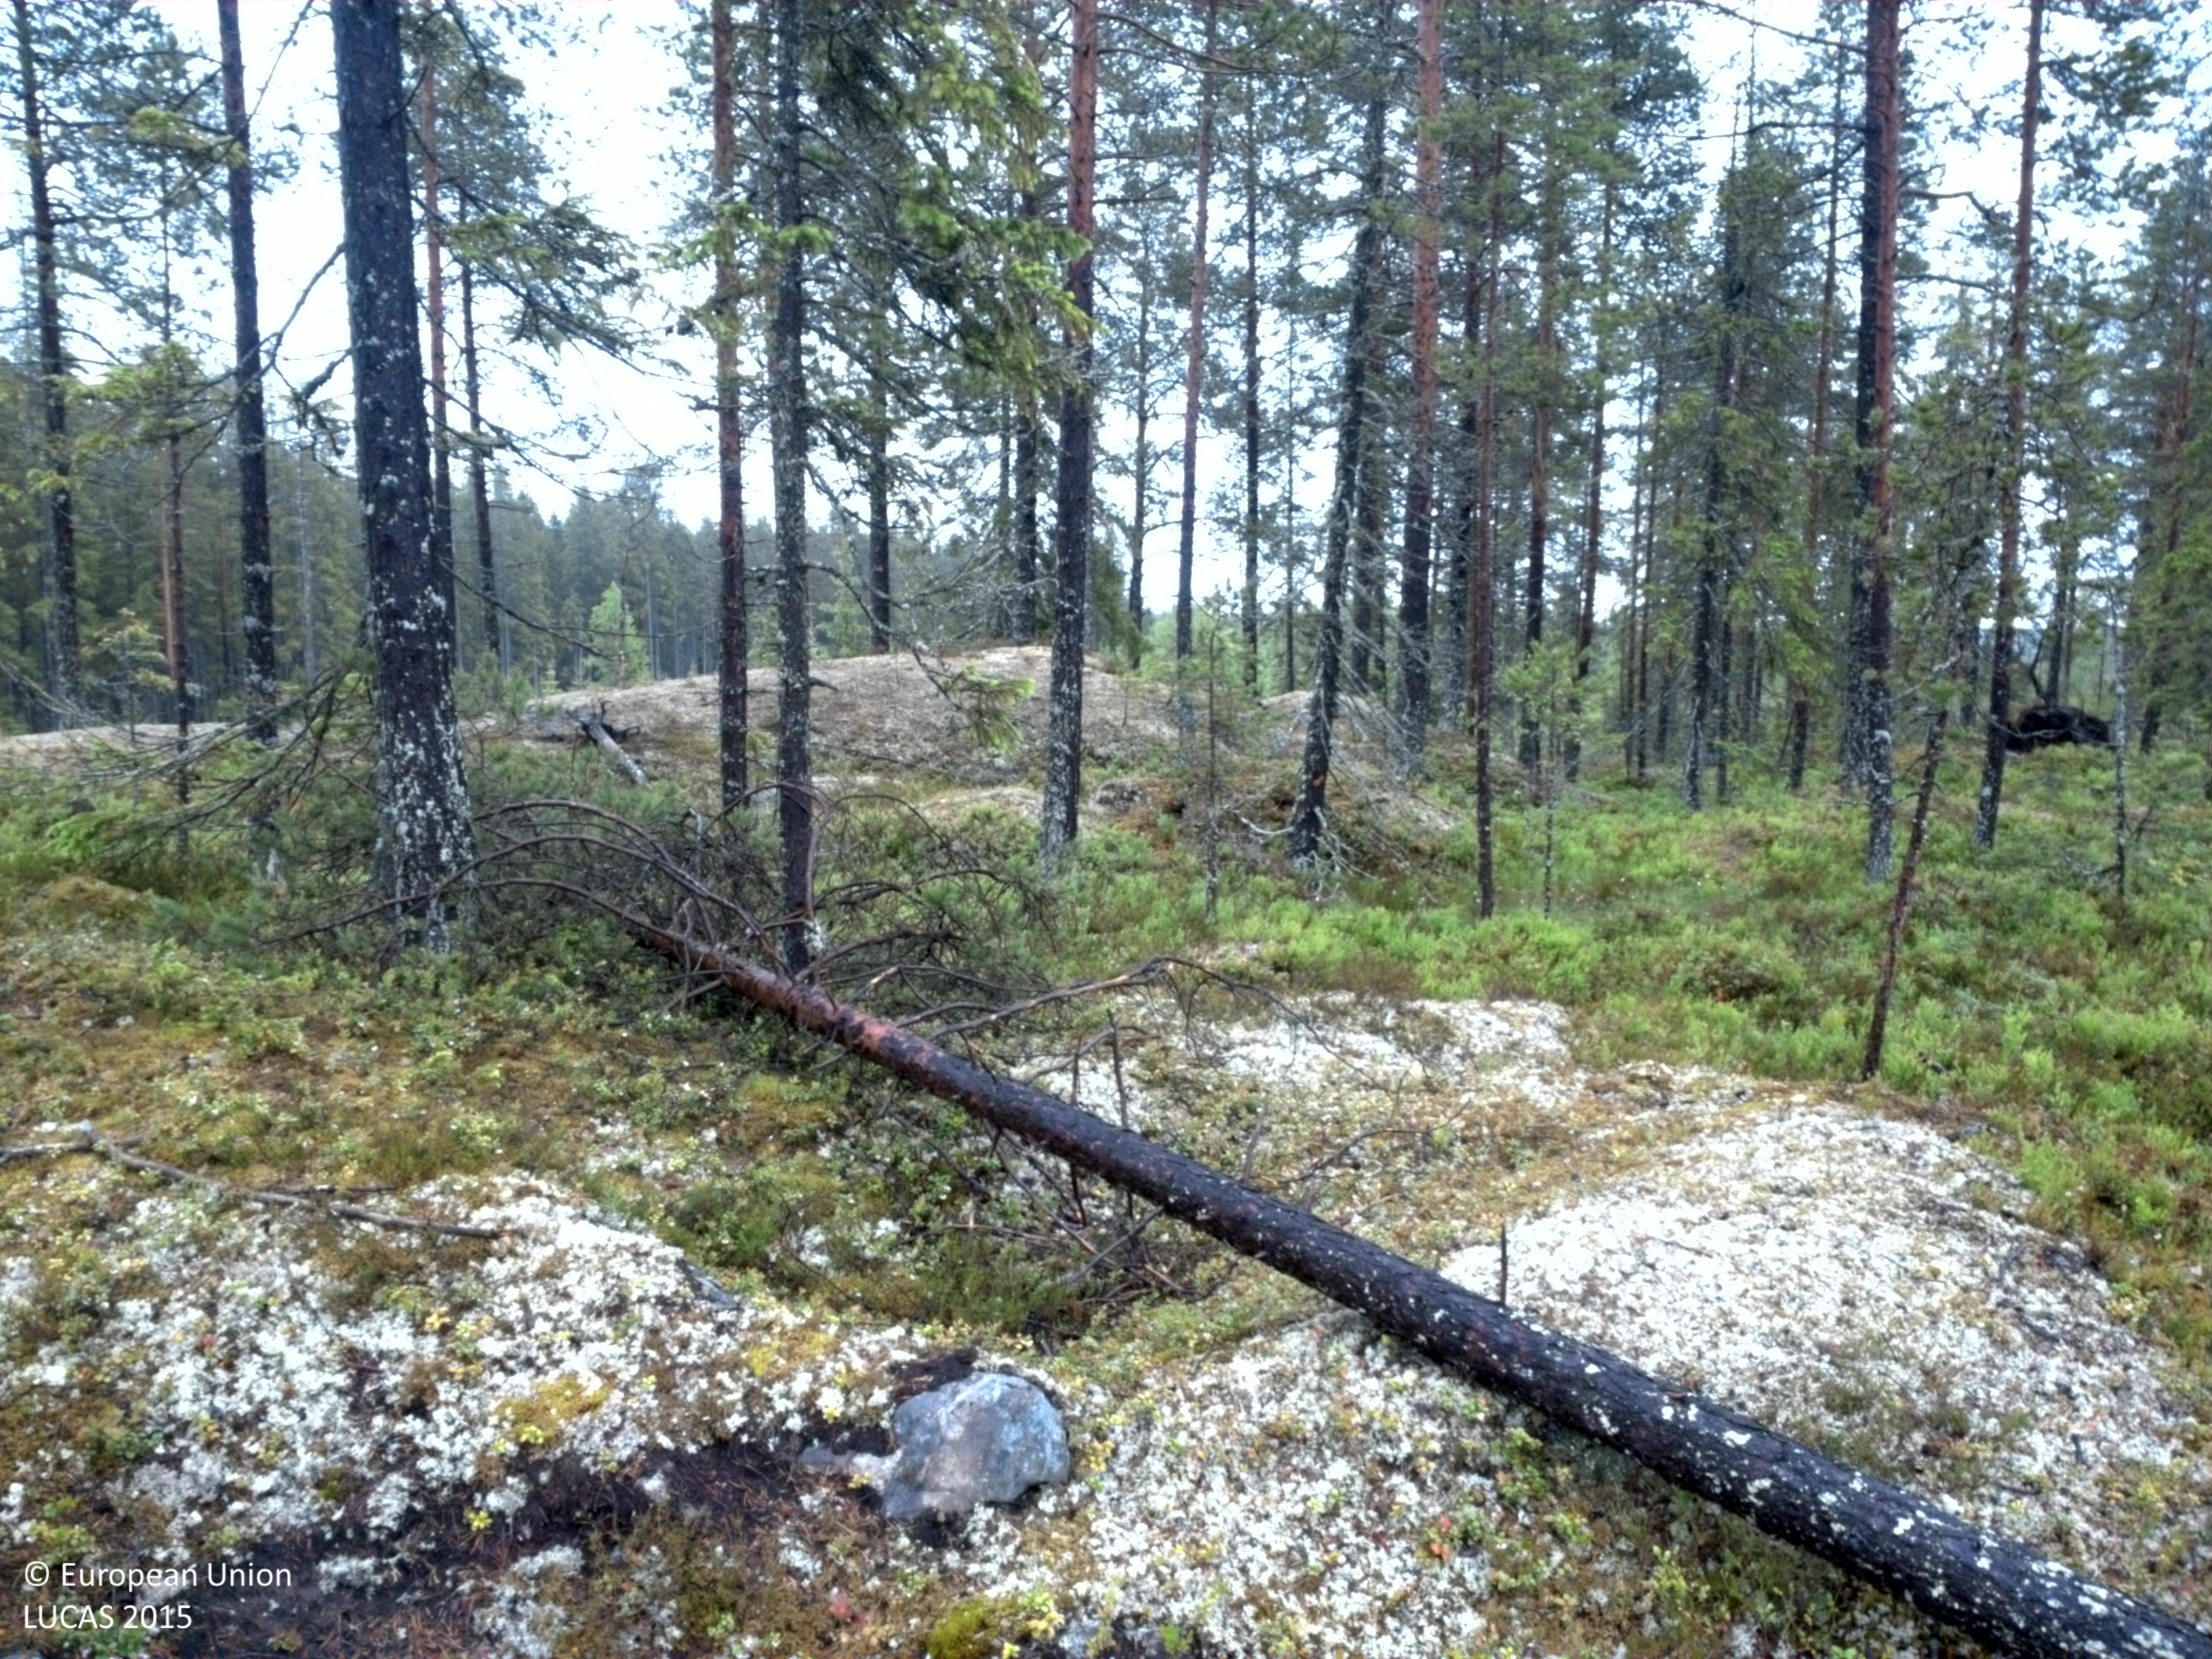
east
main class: Woodland
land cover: Pine dominated coniferous woodland
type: boreal forest
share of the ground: 25 - 50 %
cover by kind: shrubs 40 %, coniferous forest trees 35 %, lichens and mosses 20 %, consolidated bare surface 5 %
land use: Forestry
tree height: > 5 m
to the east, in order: Pine dominated coniferous woodland; Pine dominated mixed woodland; Ditches and canals; Pine dominated mixed woodland; Other coniferous woodland; Pine dominated mixed woodland; Other coniferous woodland; Spruce dominated coniferous woodland
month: June
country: SE
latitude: 64.3155
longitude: 20.8797
